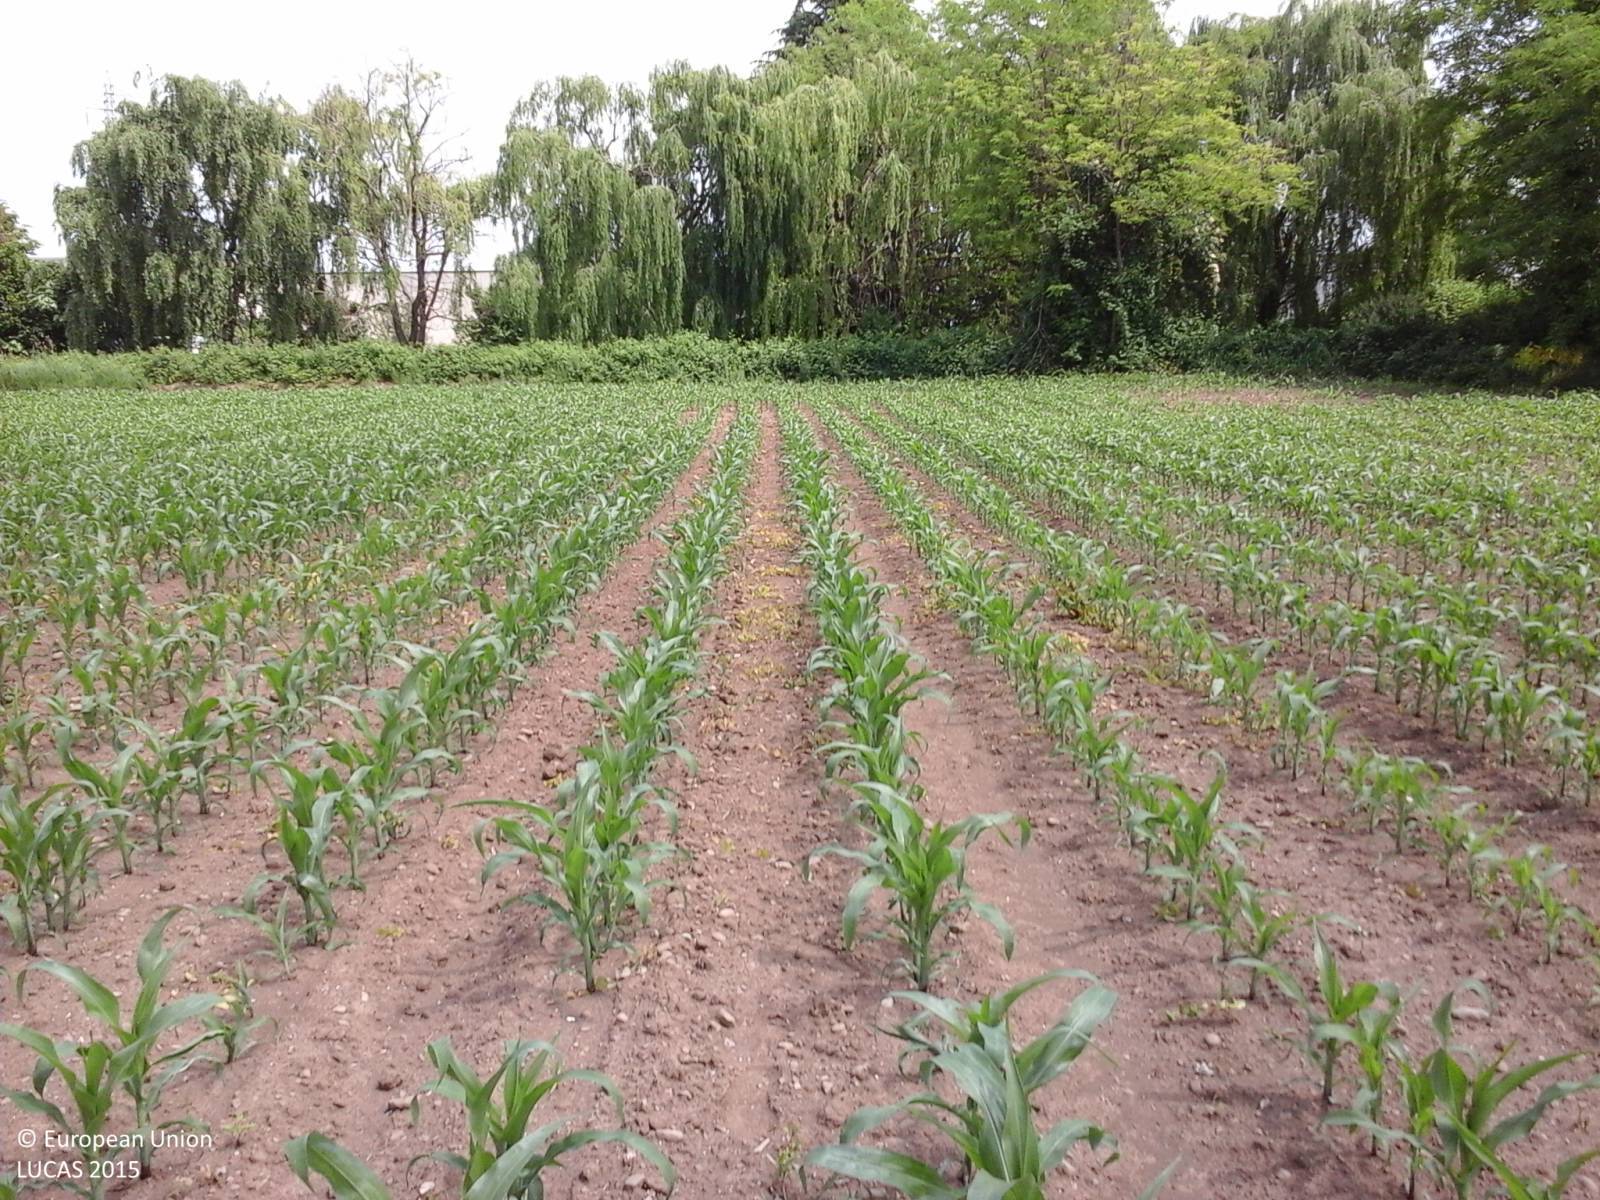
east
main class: Cropland
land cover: Maize
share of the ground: 50 - 75 %
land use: Agriculture (excluding fallow land and kitchen gardens)
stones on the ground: < 10 %
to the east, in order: Maize; Electric lines; Maize; Grass margins; Abandoned hedges; Inland fresh running water; Abandoned hedges; Fences; Grassland with sparse tree/shrub cover; Artificial constructions in urban areas
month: May
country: IT
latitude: 46.0130
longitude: 13.2639
